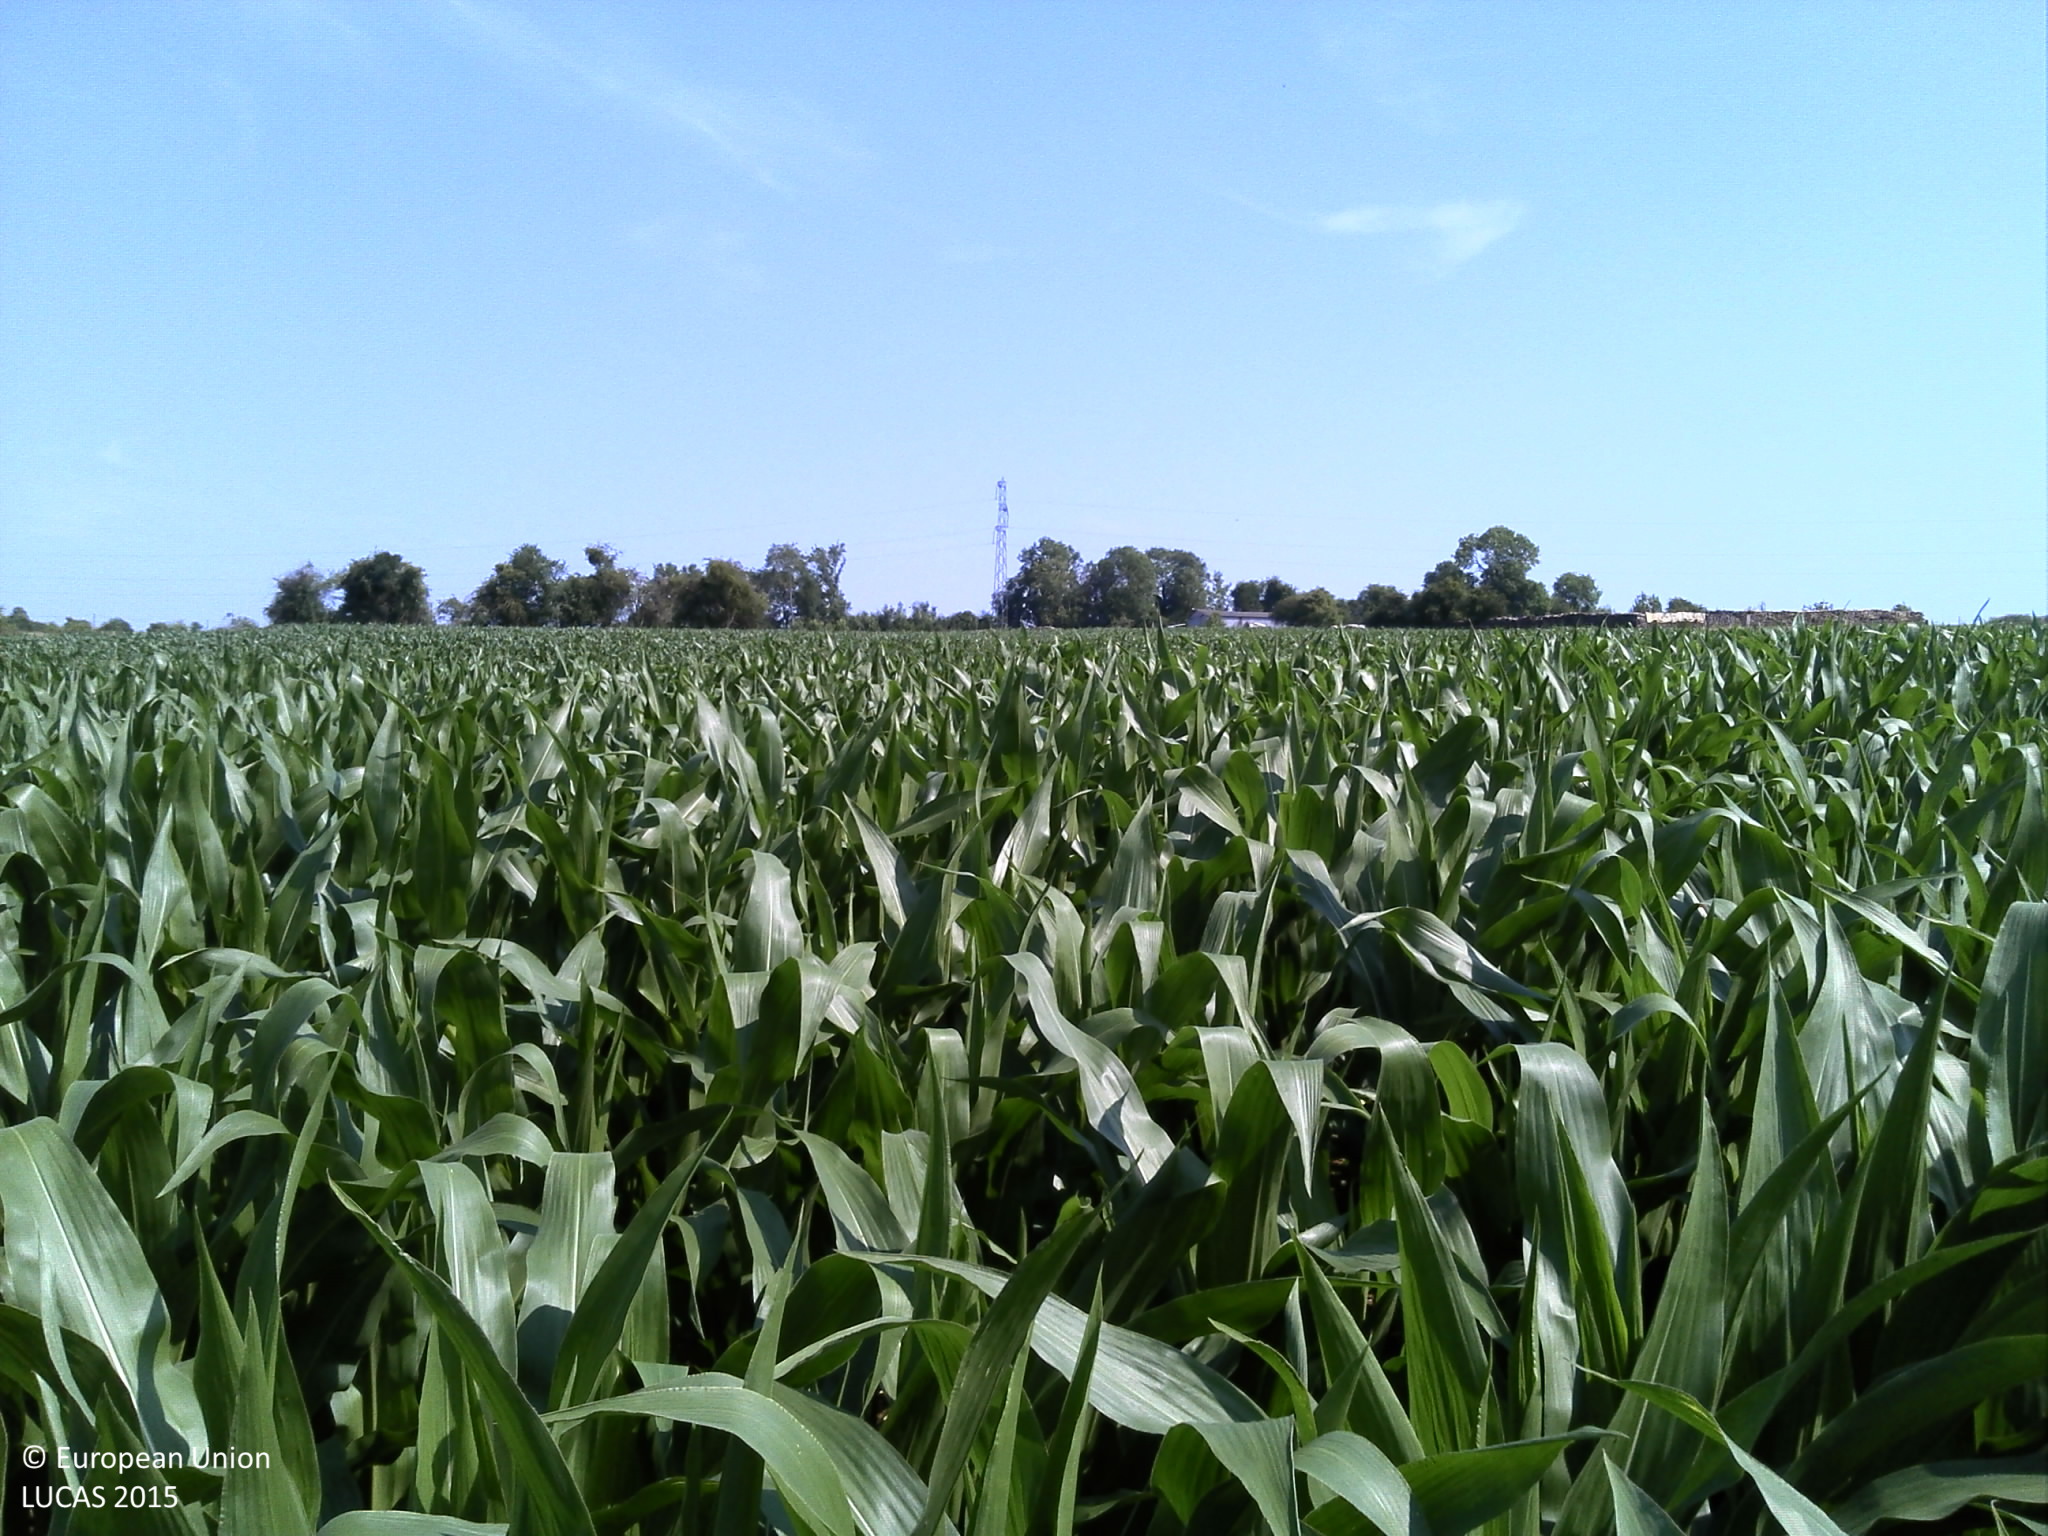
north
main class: Cropland
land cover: Maize
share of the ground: > 75 %
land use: Agriculture (excluding fallow land and kitchen gardens)
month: July
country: FR
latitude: 49.7982
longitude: 4.4806
